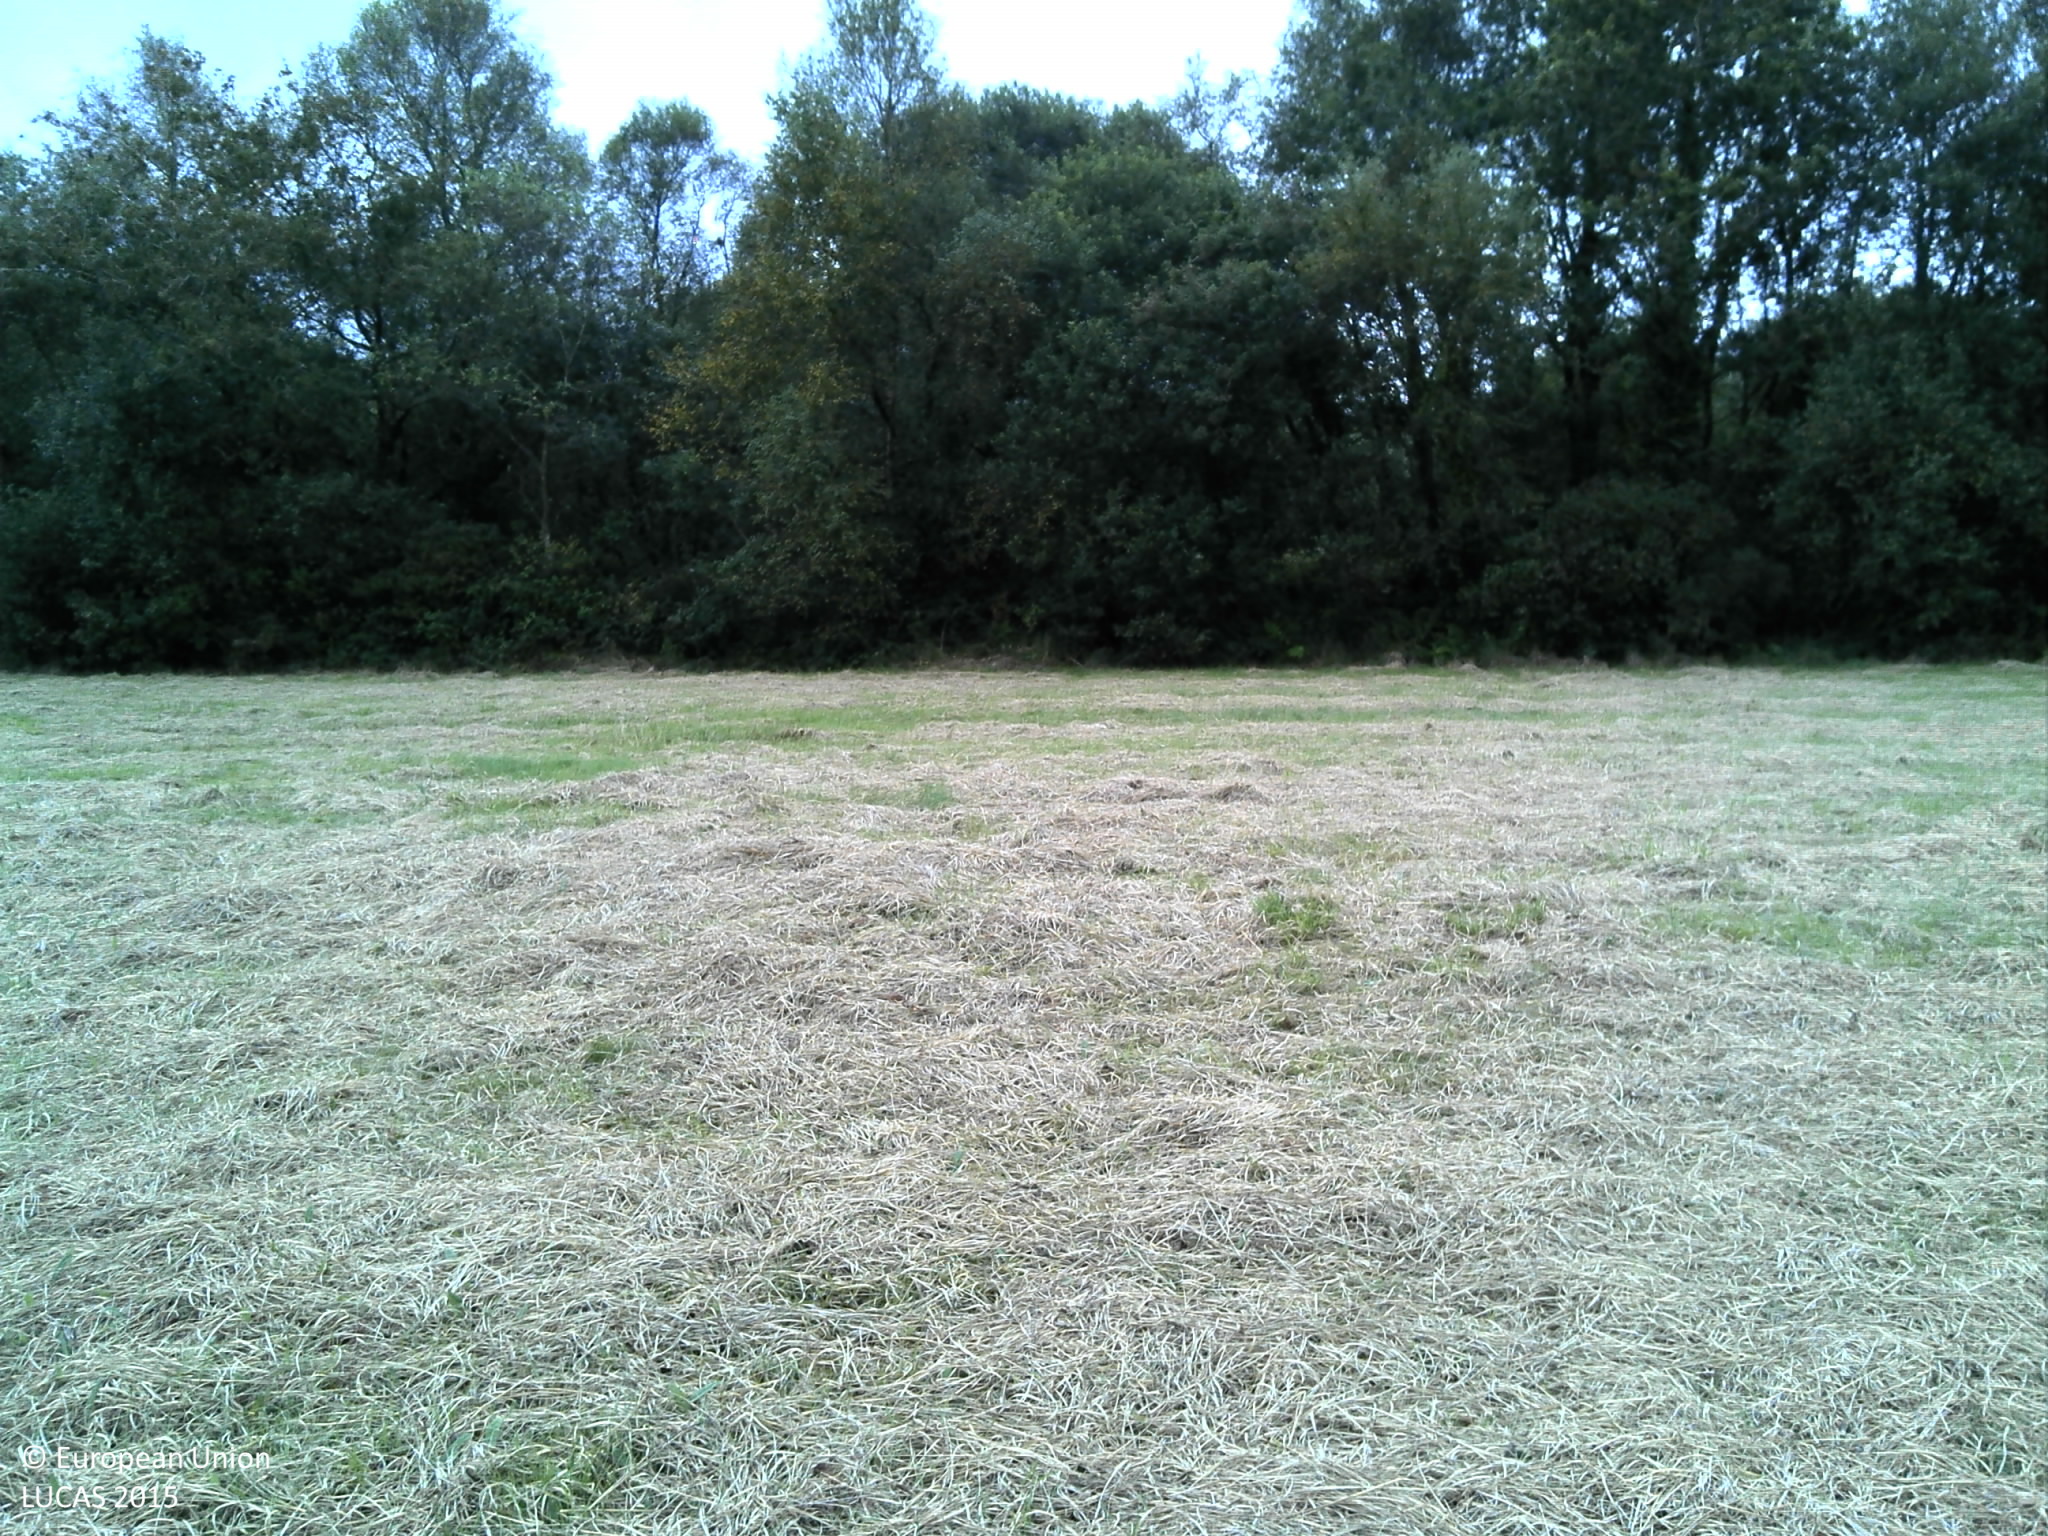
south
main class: Grassland
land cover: Grassland without tree/shrub cover
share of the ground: > 75 %
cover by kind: herbaceous plants 100 %
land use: Agriculture (excluding fallow land and kitchen gardens)
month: September
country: FR
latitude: 48.5136
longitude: -4.2678
